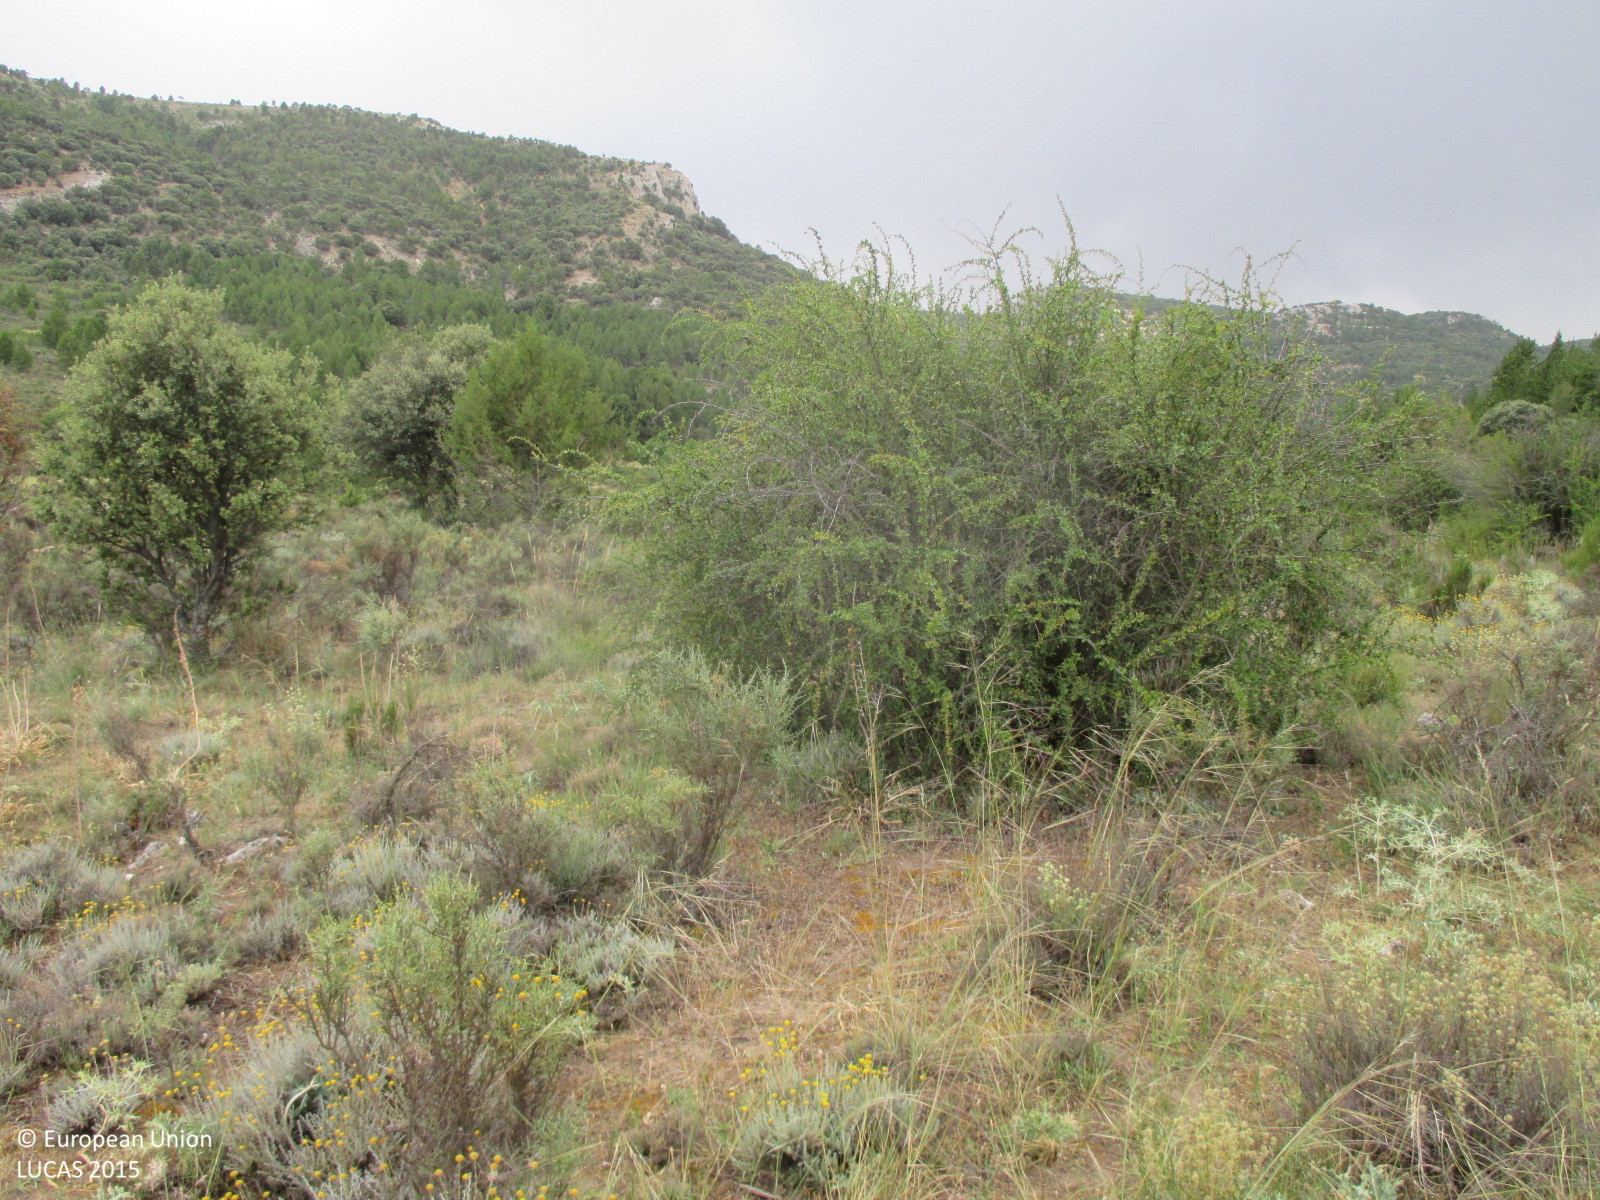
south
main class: Shrubland
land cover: Shrubland without tree cover
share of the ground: 50 - 75 %
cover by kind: shrubs 50 %, herbaceous plants 50 %
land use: Semi-natural and natural areas not in use
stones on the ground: < 10 %
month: July
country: ES
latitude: 38.1243
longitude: -2.3929
